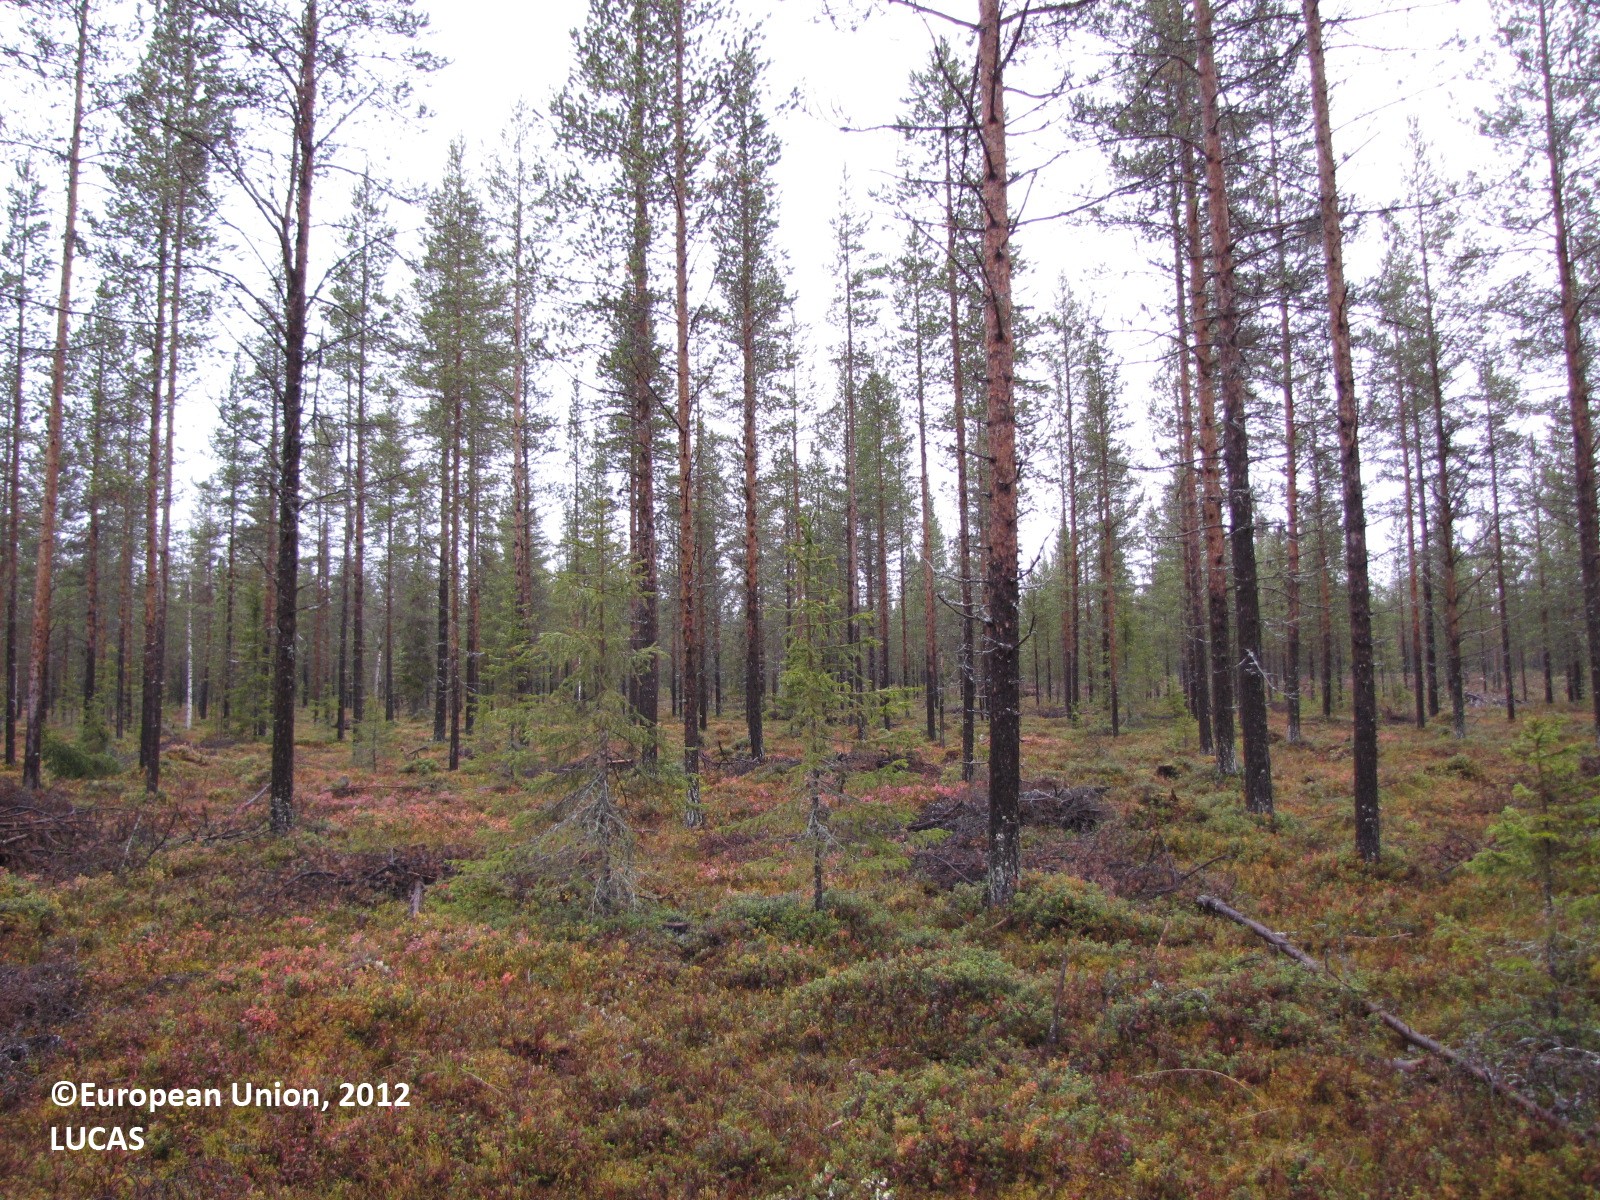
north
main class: Woodland
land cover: Pine dominated coniferous woodland
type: boreal forest
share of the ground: 25 - 50 %
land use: Forestry
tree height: > 5 m
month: September
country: FI
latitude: 67.6440
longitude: 23.5614
